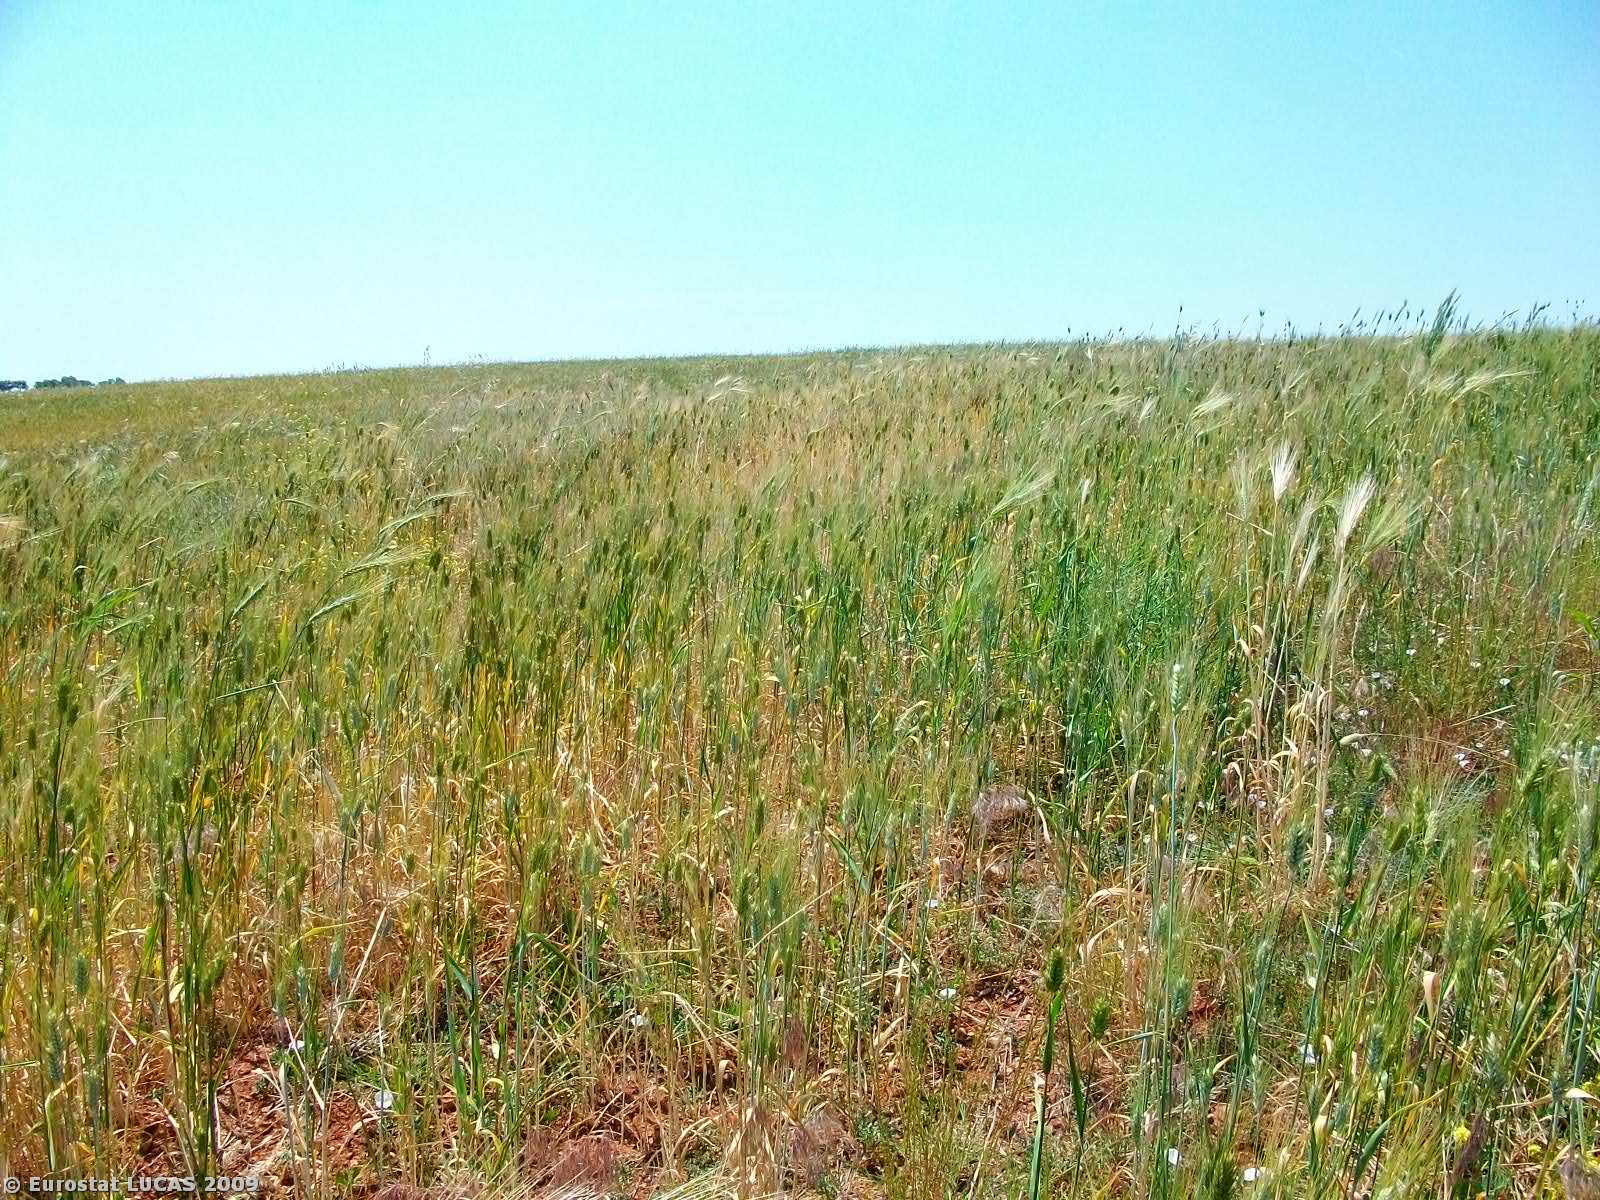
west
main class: Cropland
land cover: Durum wheat
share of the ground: > 75 %
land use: Agriculture (excluding fallow land and kitchen gardens)
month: May
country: GR
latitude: 40.9276
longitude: 25.4514
